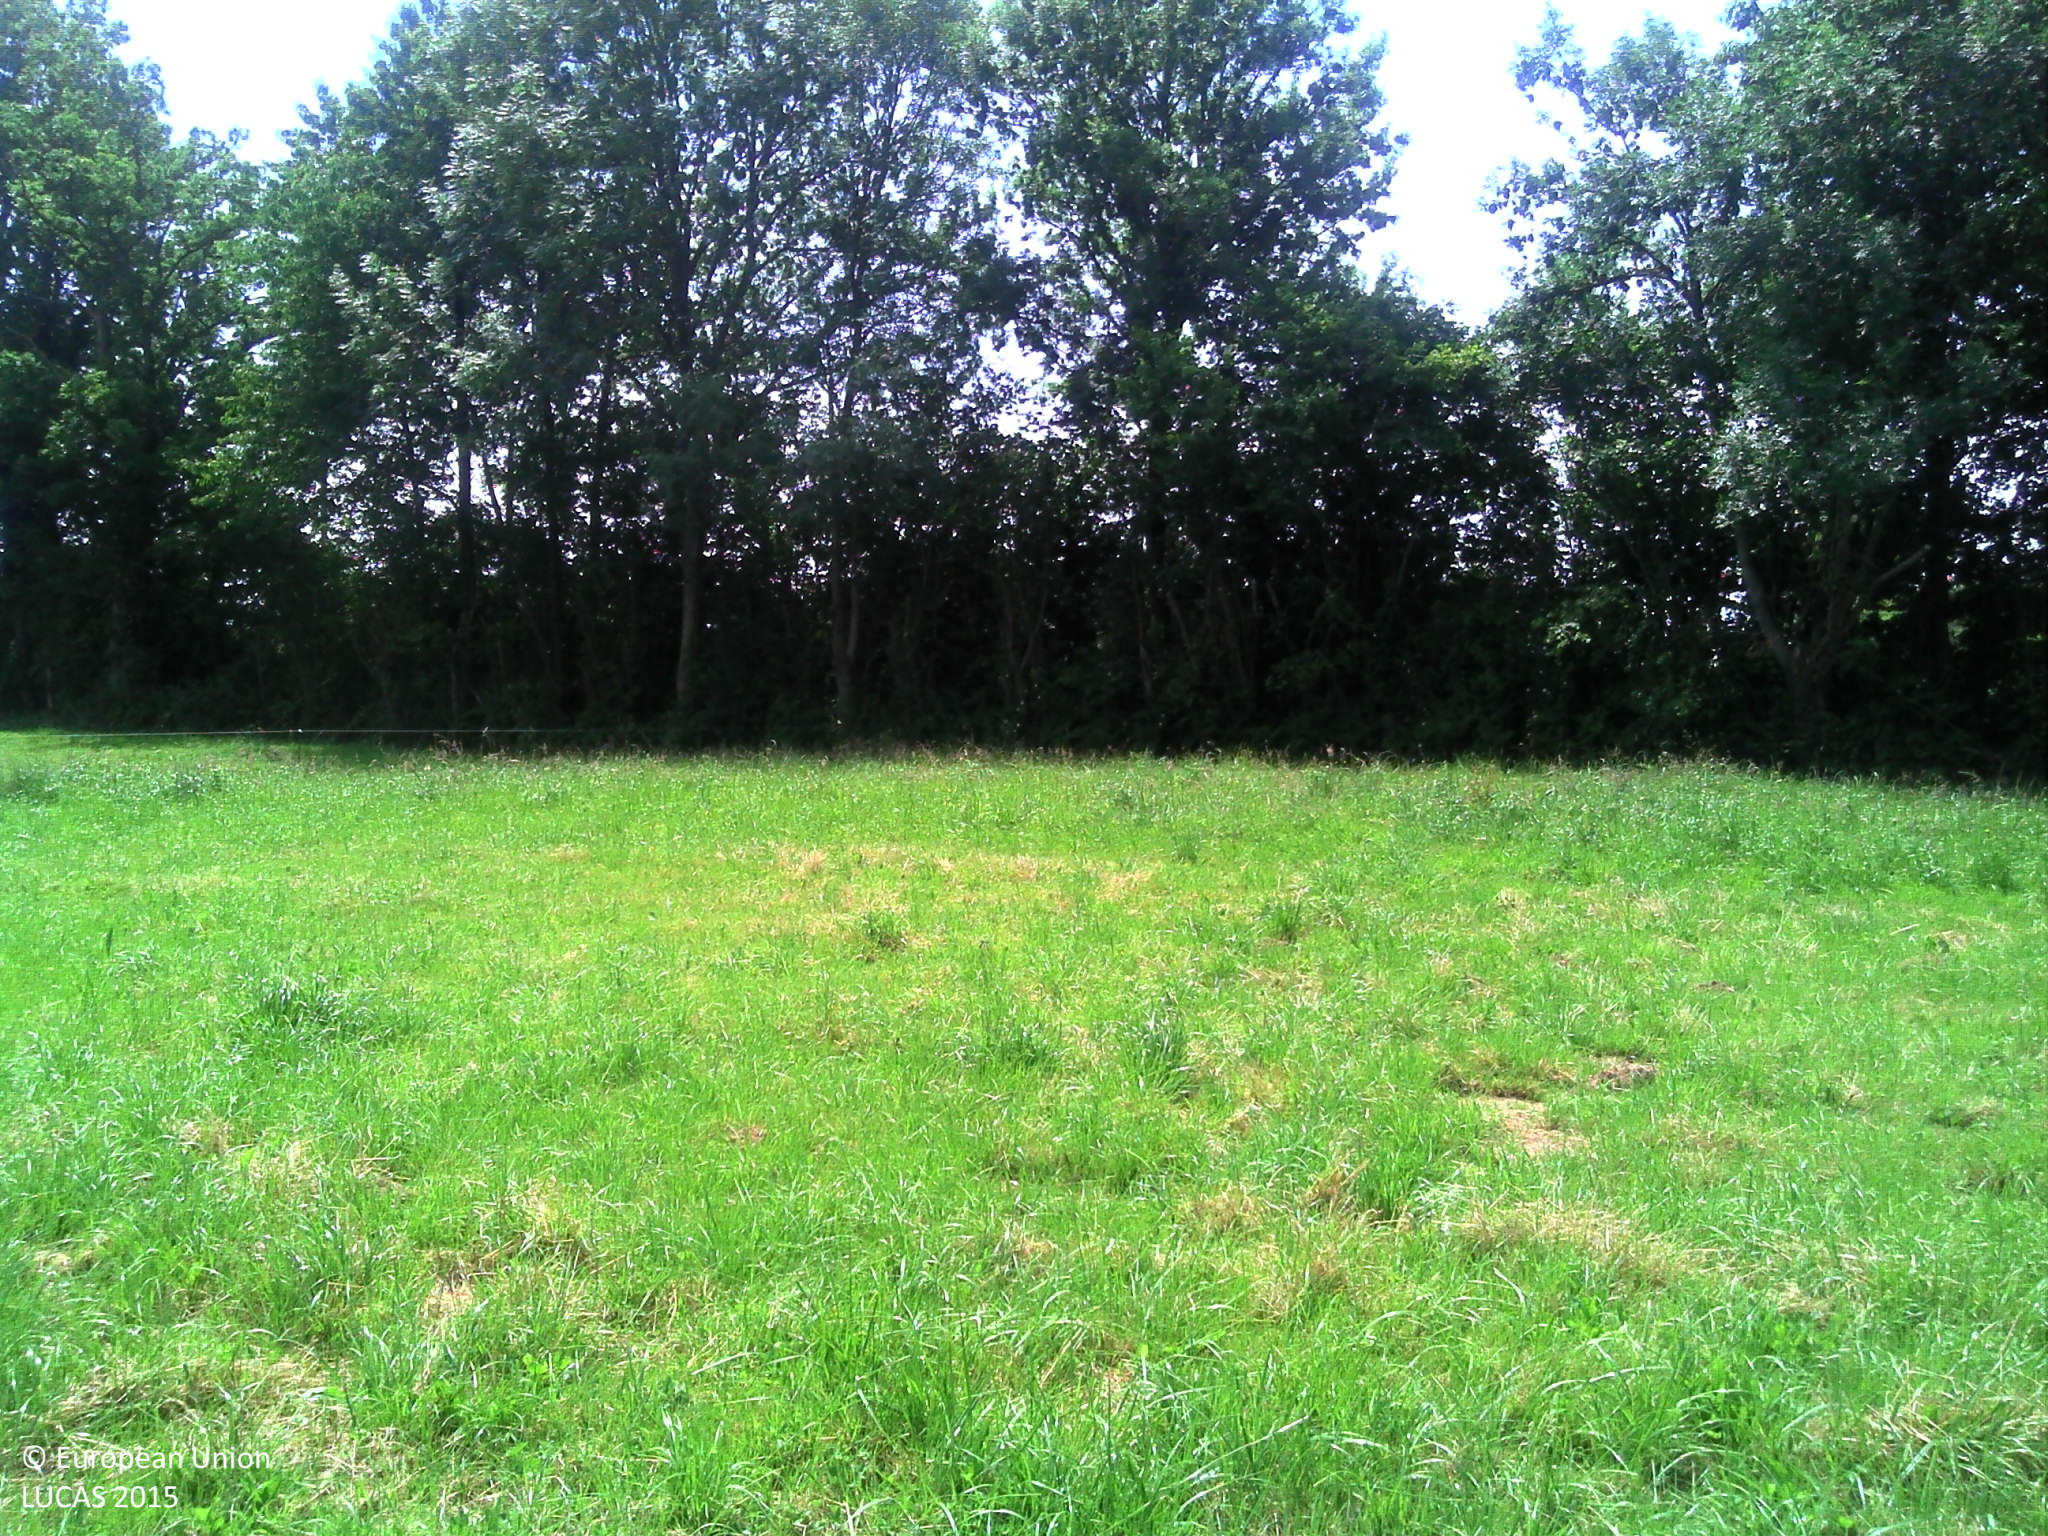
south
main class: Grassland
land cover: Grassland without tree/shrub cover
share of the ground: > 75 %
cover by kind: herbaceous plants 100 %
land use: Agriculture (excluding fallow land and kitchen gardens)
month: June
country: FR
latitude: 48.7958
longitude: -0.2564
